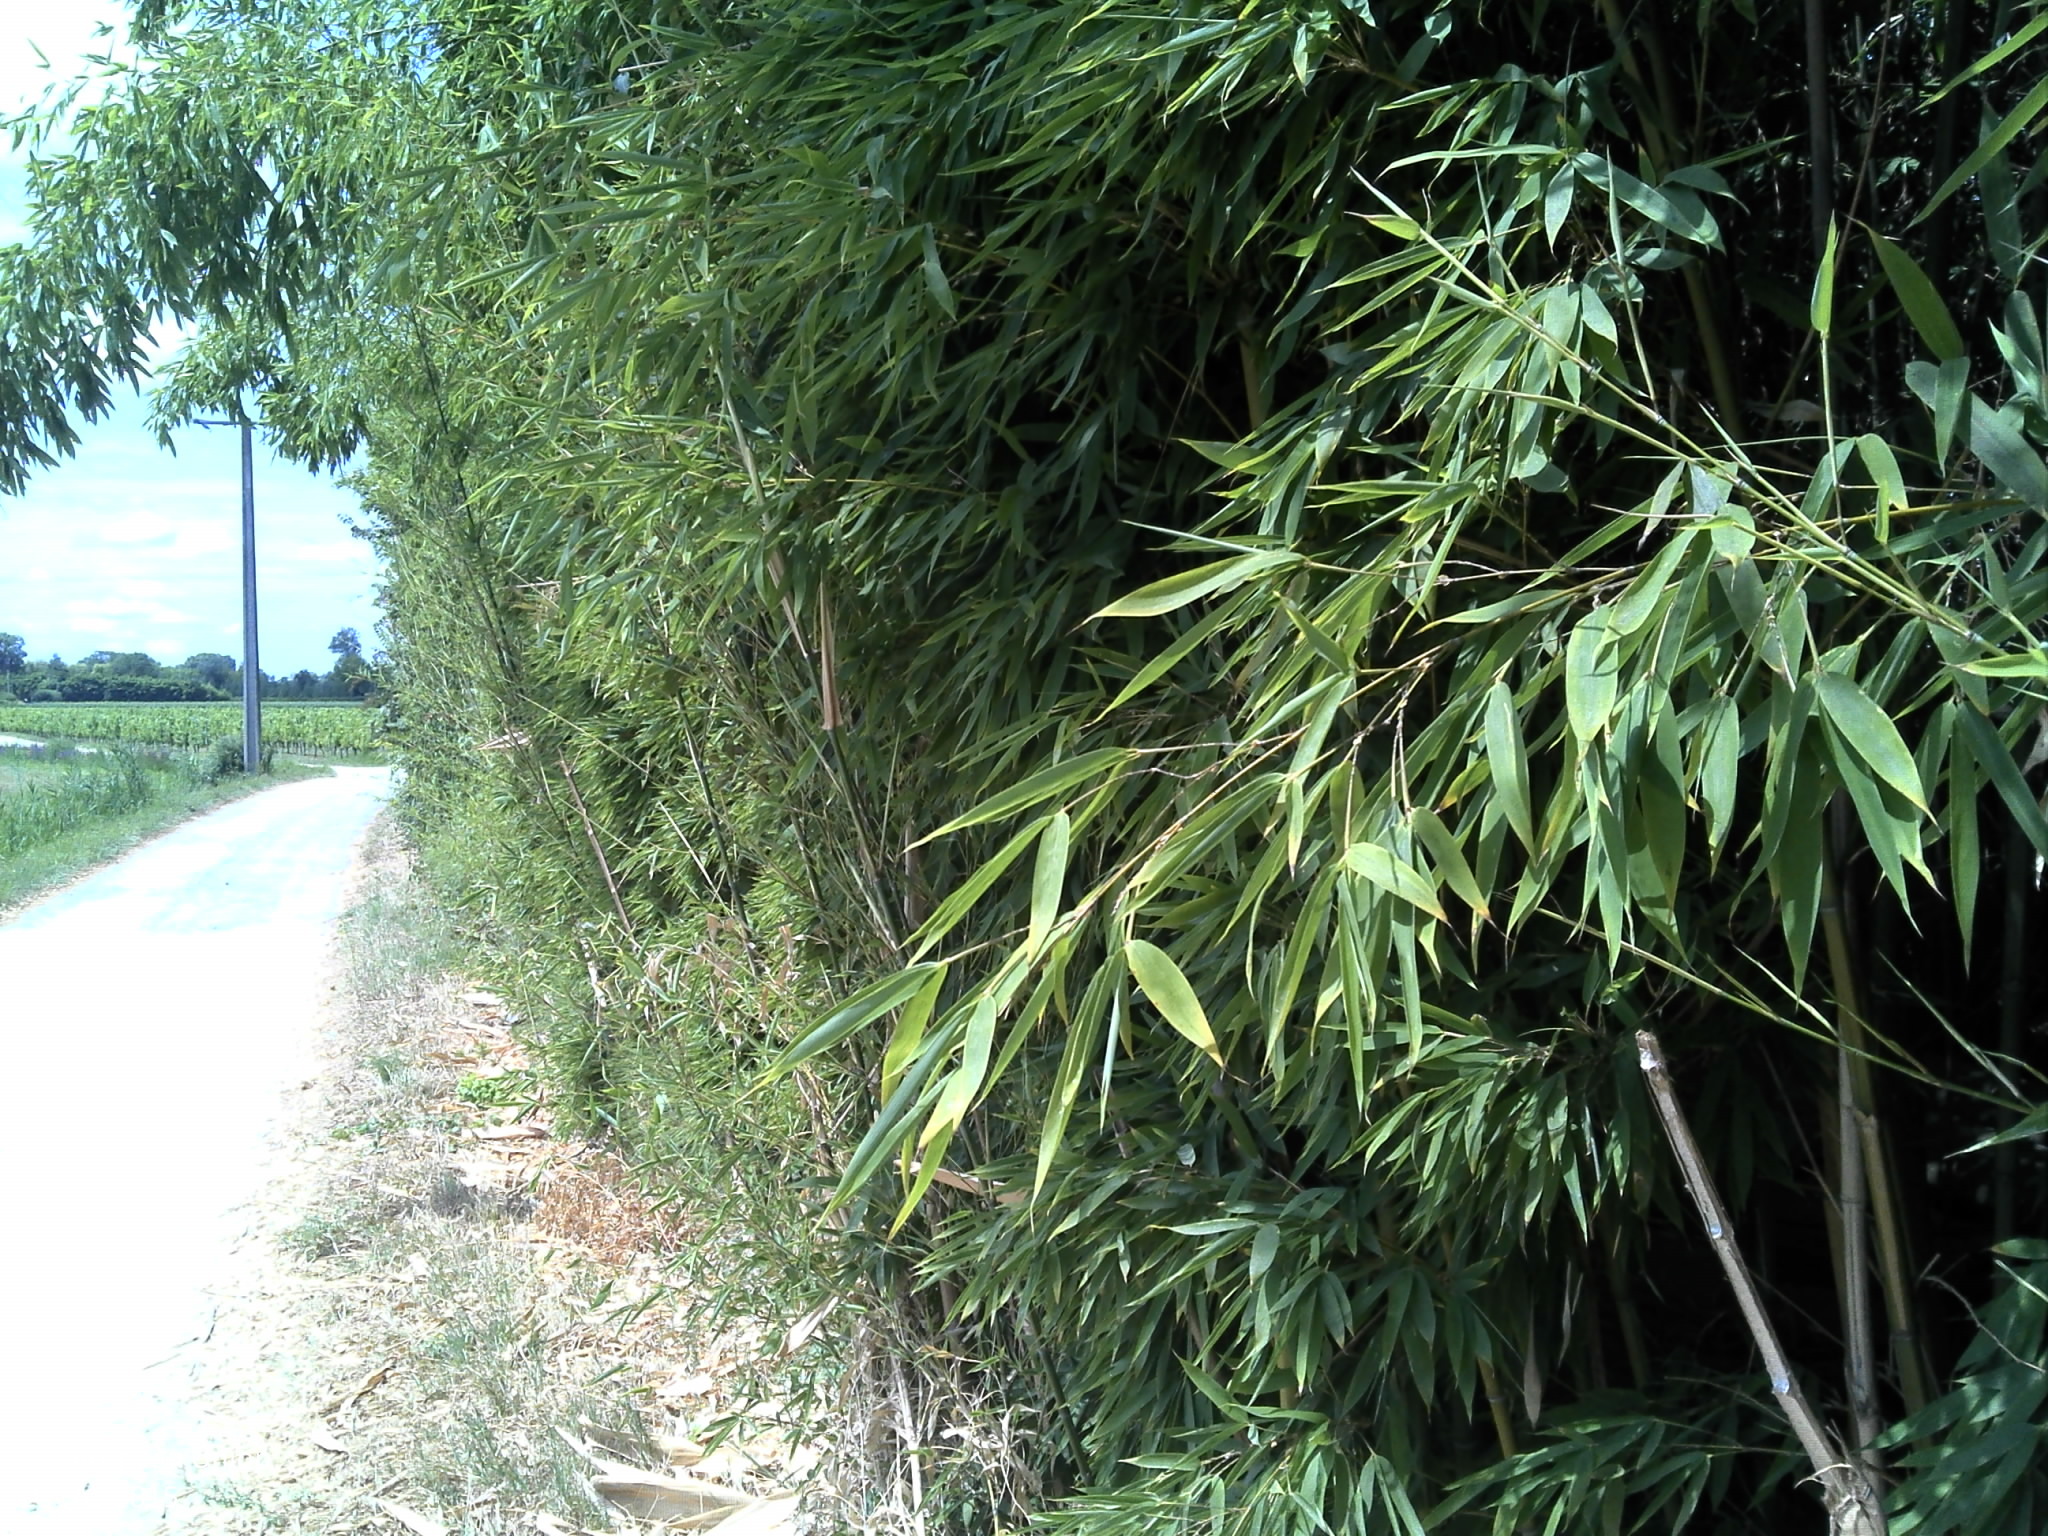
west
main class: Woodland
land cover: Broadleaved woodland
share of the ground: > 75 %
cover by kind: broadleaved forest trees 100 %
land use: Residential
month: July
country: FR
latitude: 44.7445
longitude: -0.4873
